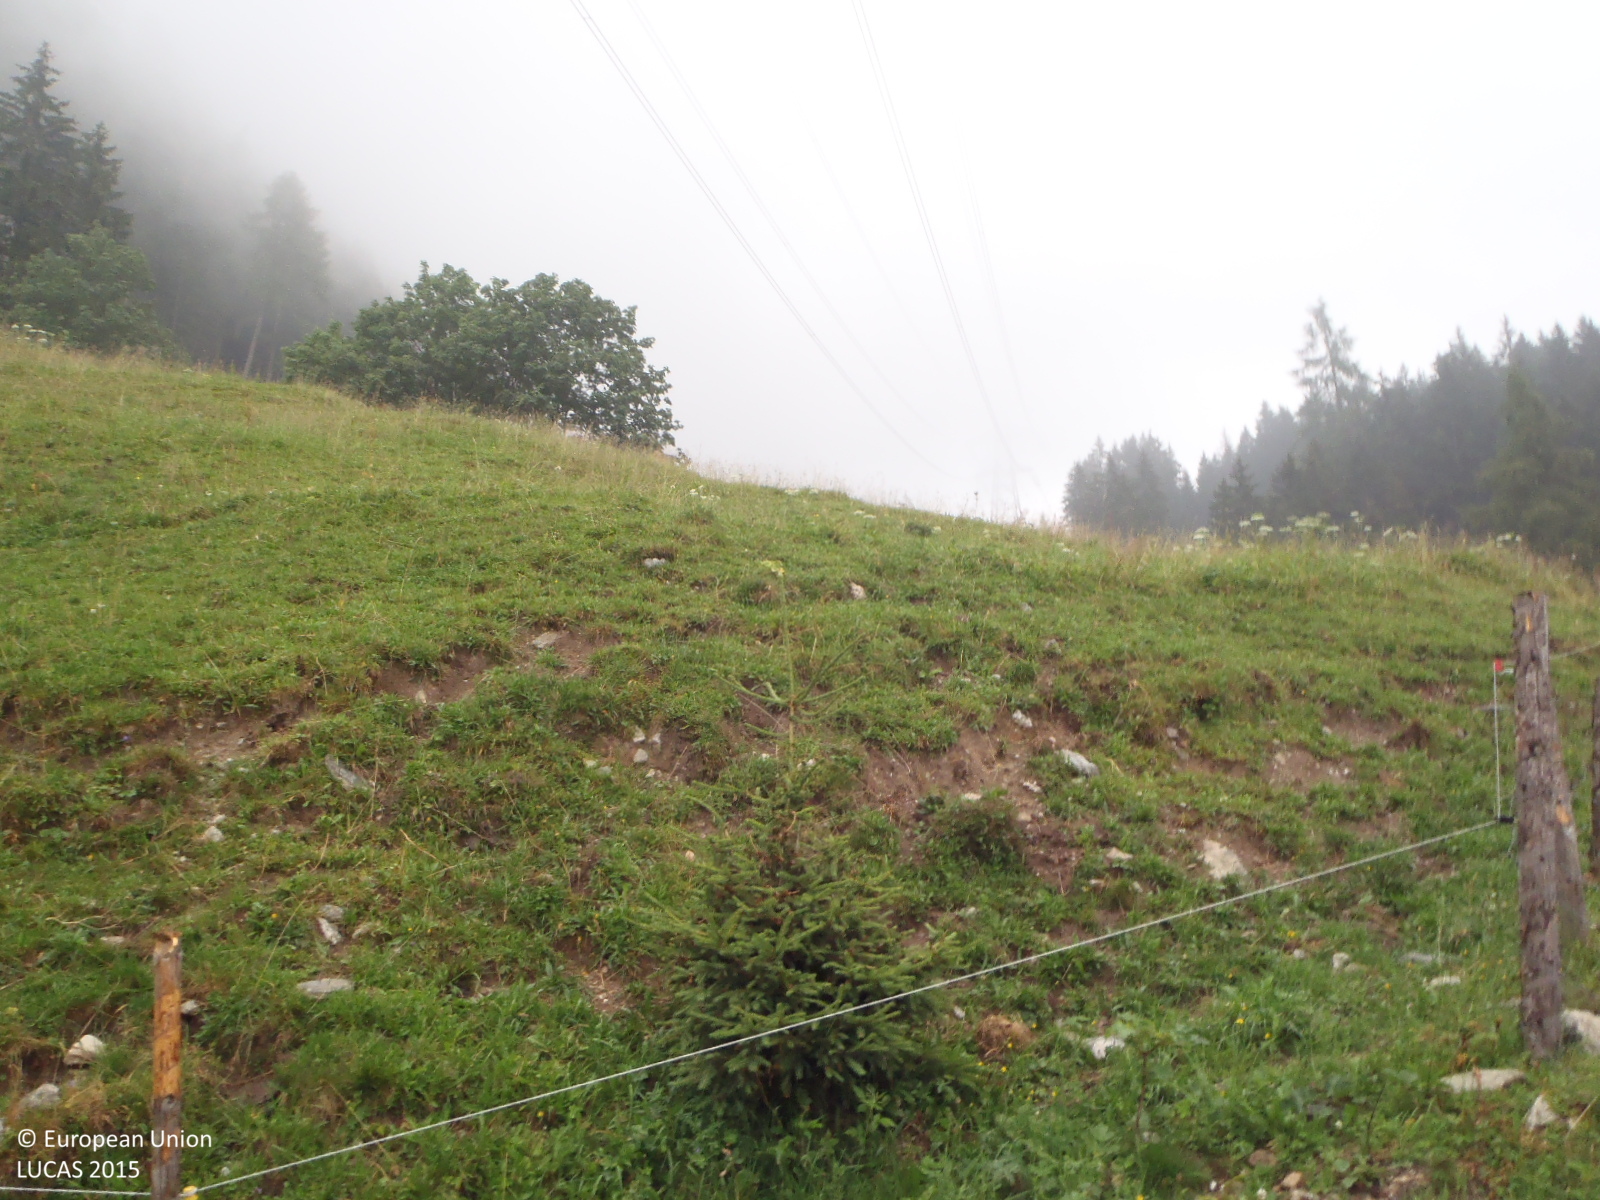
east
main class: Grassland
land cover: Grassland without tree/shrub cover
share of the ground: > 75 %
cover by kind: herbaceous plants 100 %
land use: Agriculture (excluding fallow land and kitchen gardens)
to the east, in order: Grassland without tree/shrub cover; Fences; Grassland without tree/shrub cover; Fences; Grassland with sparse tree/shrub cover; Electric lines; Grassland with sparse tree/shrub cover; Spruce dominated coniferous woodland; Shrubland with sparse tree cover; Rocks and stones; Shrubland with sparse tree cover
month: July
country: AT
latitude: 47.2158
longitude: 11.9657
